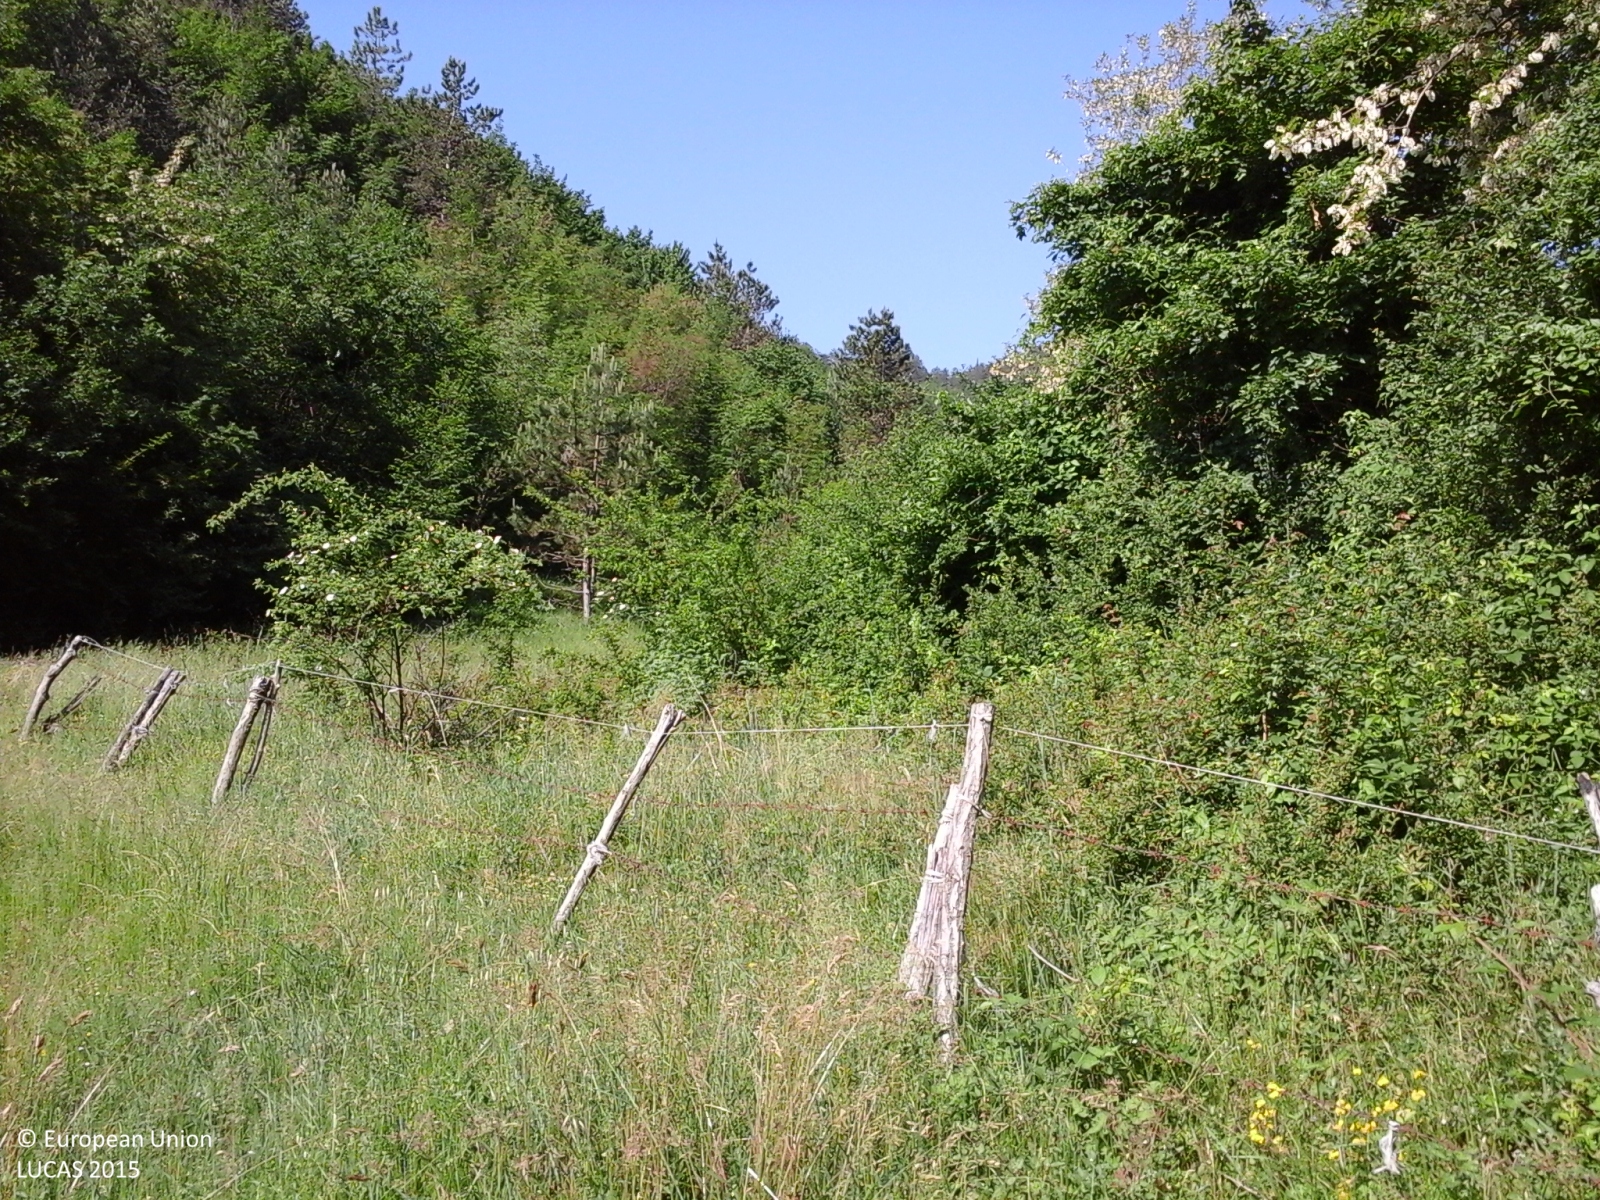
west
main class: Grassland
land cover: Grassland without tree/shrub cover
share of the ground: > 75 %
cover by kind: herbaceous plants 100 %
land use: Agriculture (excluding fallow land and kitchen gardens)
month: May
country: IT
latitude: 44.0083
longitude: 11.9037
